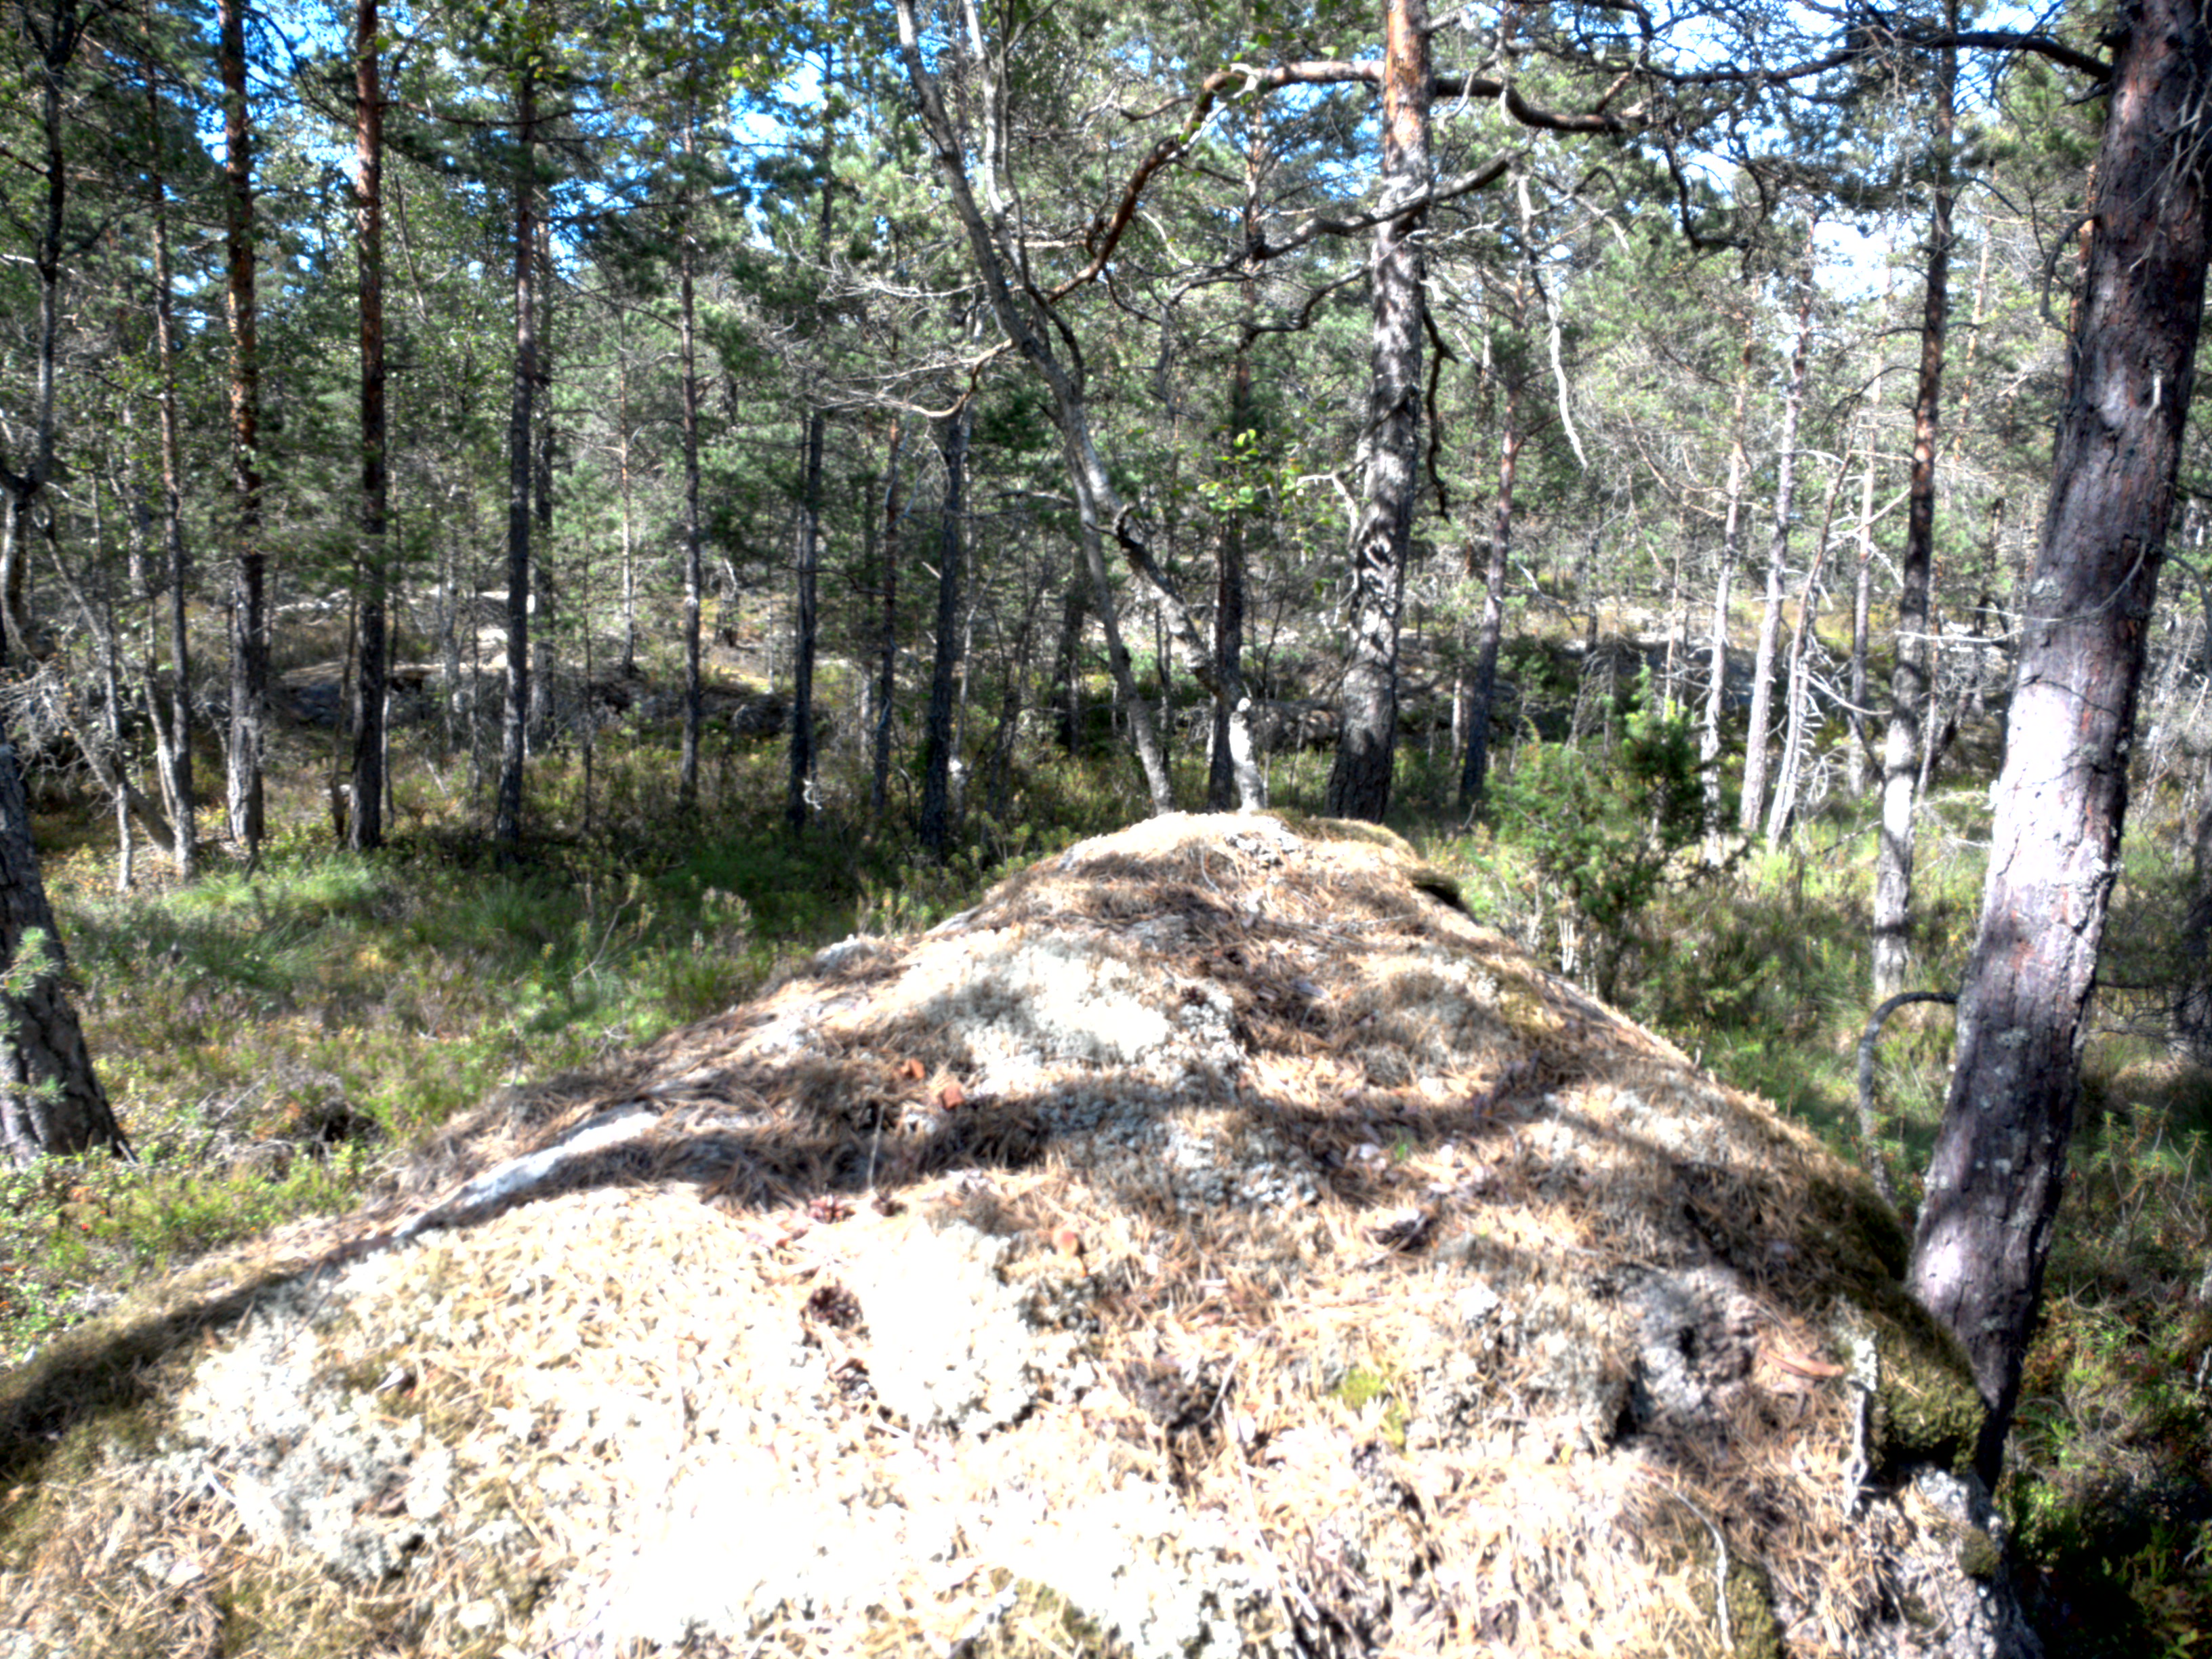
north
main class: Woodland
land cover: Pine dominated coniferous woodland
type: boreal forest
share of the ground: 25 - 50 %
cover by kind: coniferous forest trees 50 %, shrubs 25 %, lichens and mosses 25 %
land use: Forestry
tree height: > 5 m
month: August
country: SE
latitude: 59.0955
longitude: 17.4856
